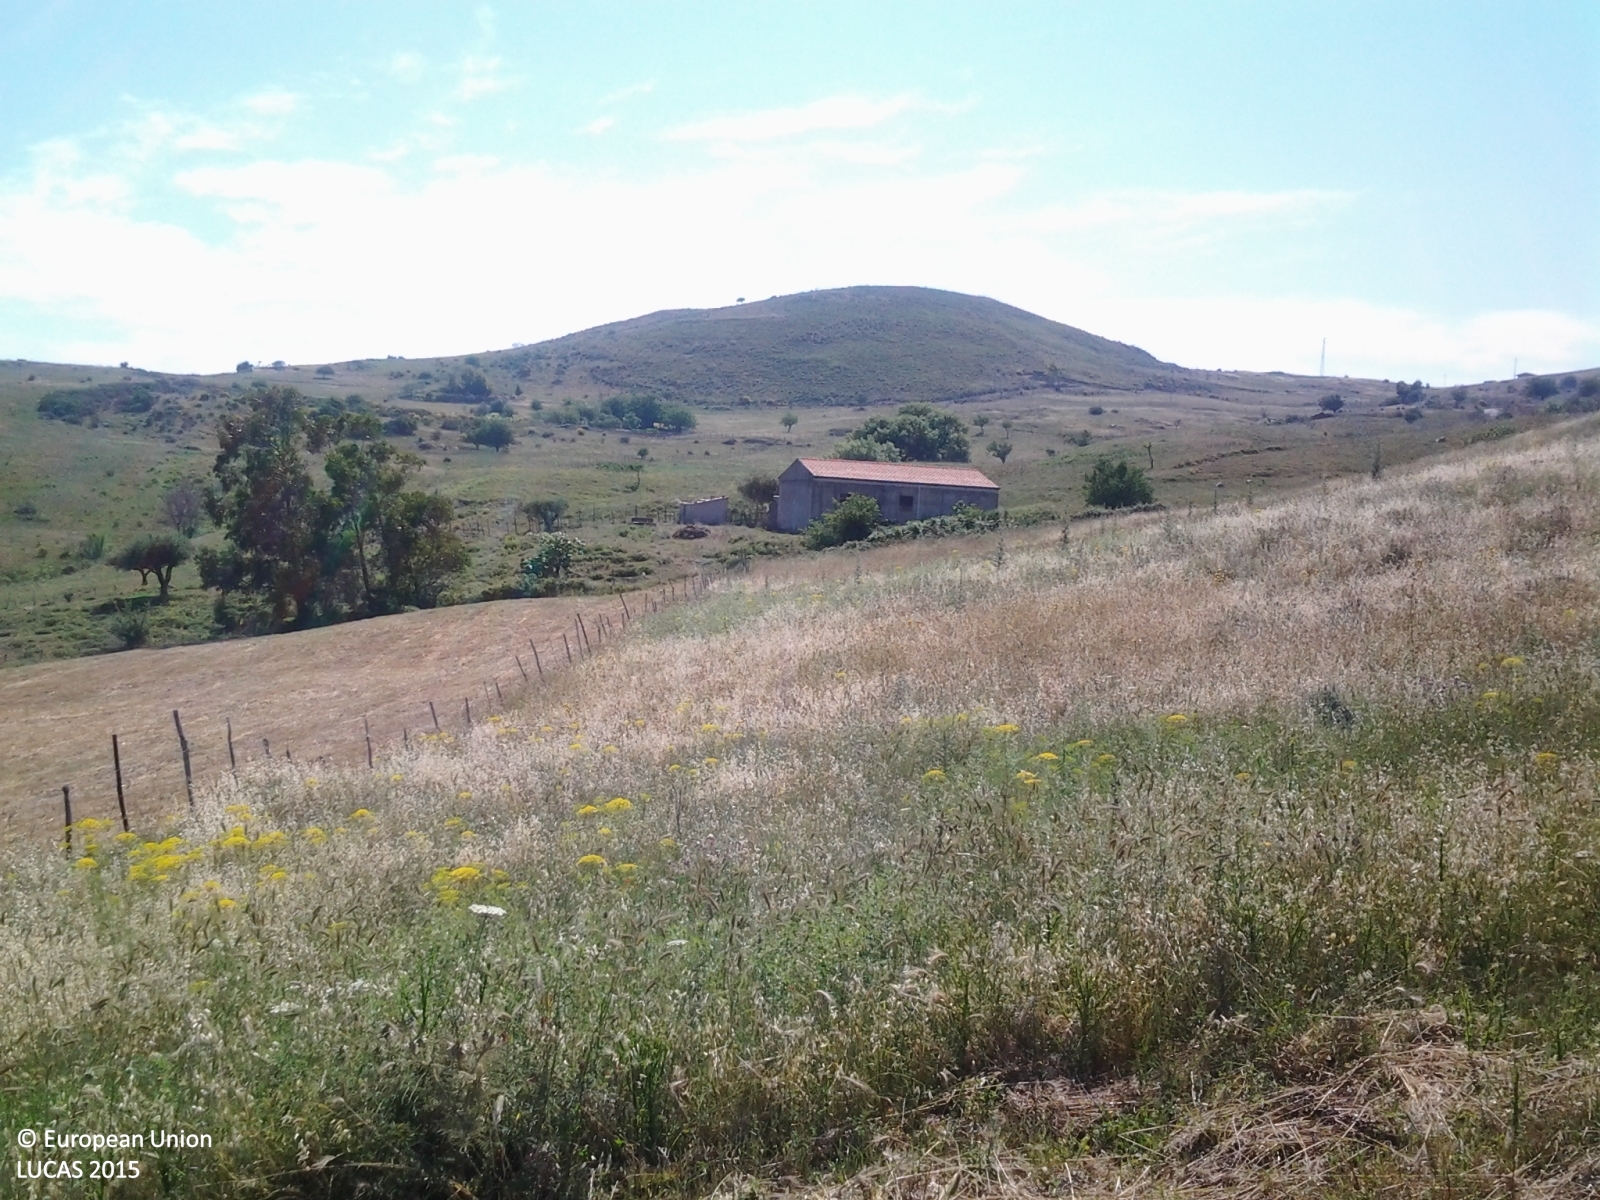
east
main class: Cropland
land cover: Mixed cereals for fodder
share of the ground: > 75 %
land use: Agriculture (excluding fallow land and kitchen gardens)
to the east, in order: Mixed cereals for fodder; Fences; Mixed cereals for fodder; Fences; Mixed cereals for fodder; Fences; Ditches and canals; Fences; Grassland without tree/shrub cover; Artificial constructions in urban areas; Grassland without tree/shrub cover
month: June
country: IT
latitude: 37.9811
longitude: 14.2174
